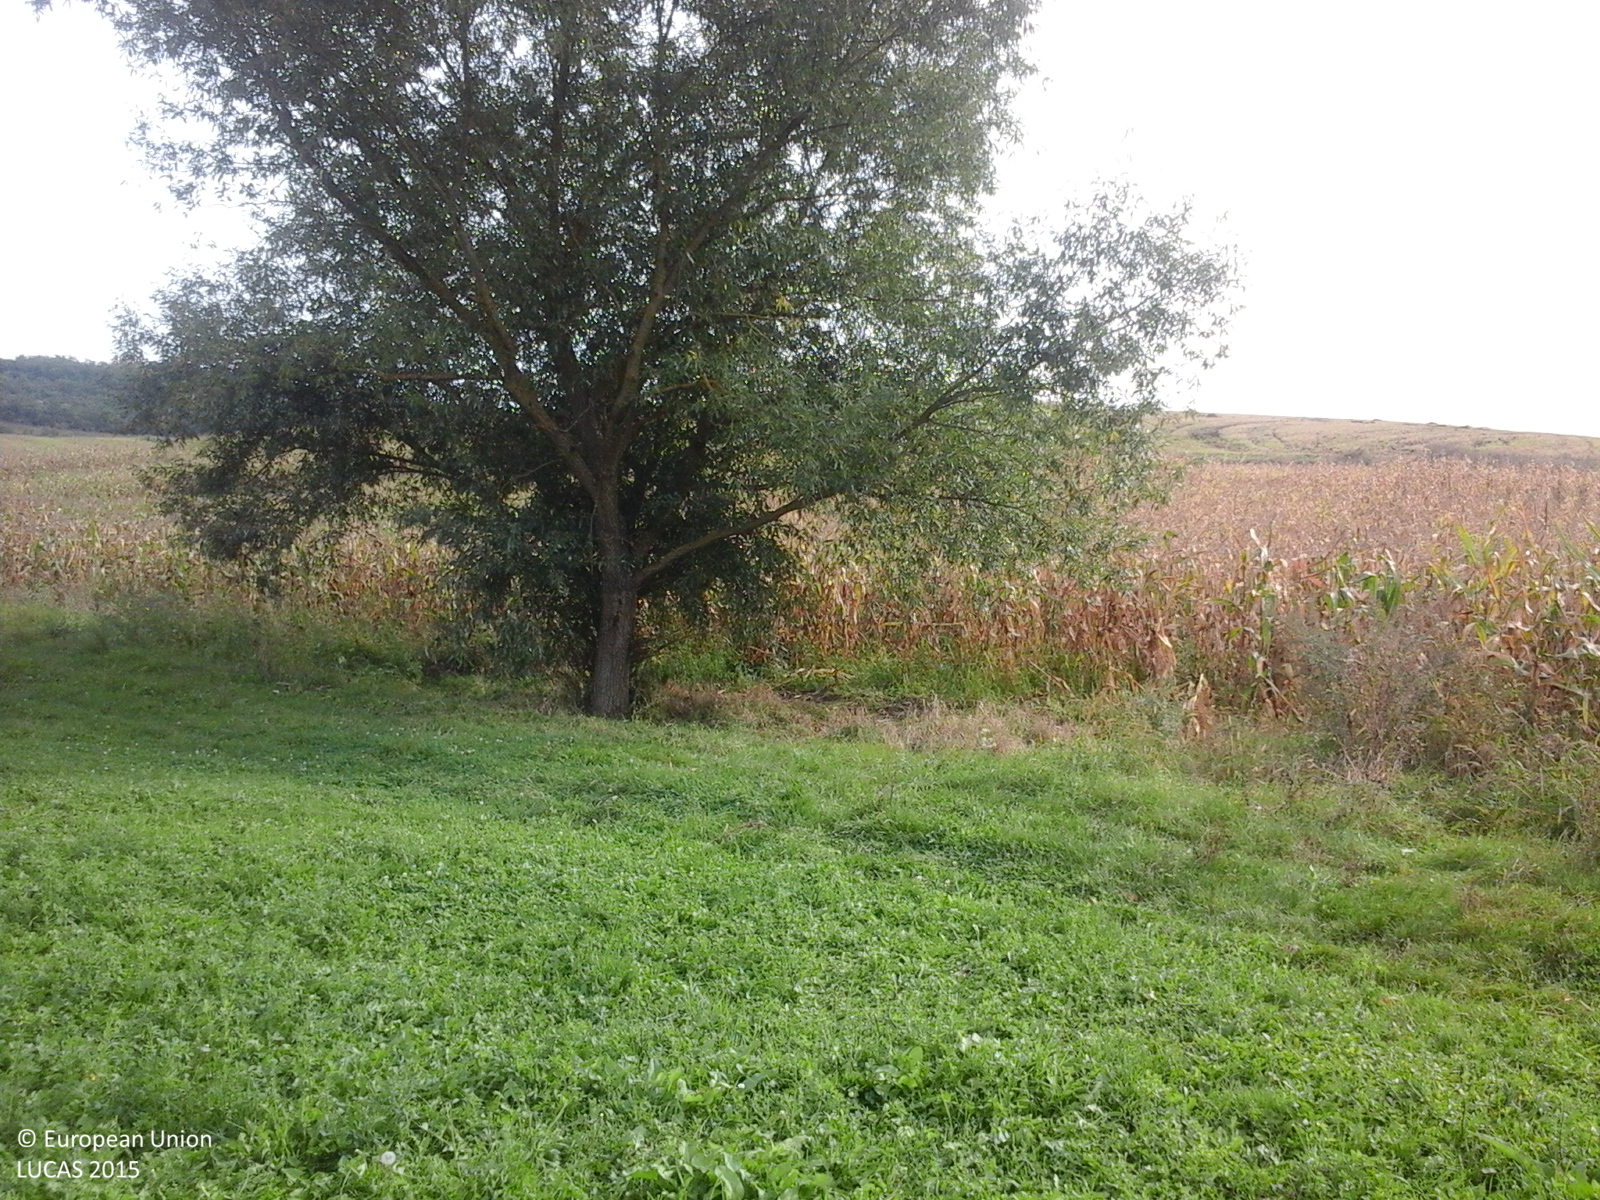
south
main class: Cropland
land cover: Lucerne
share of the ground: > 75 %
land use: Agriculture (excluding fallow land and kitchen gardens)
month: September
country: RO
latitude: 46.7915
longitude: 24.1649
